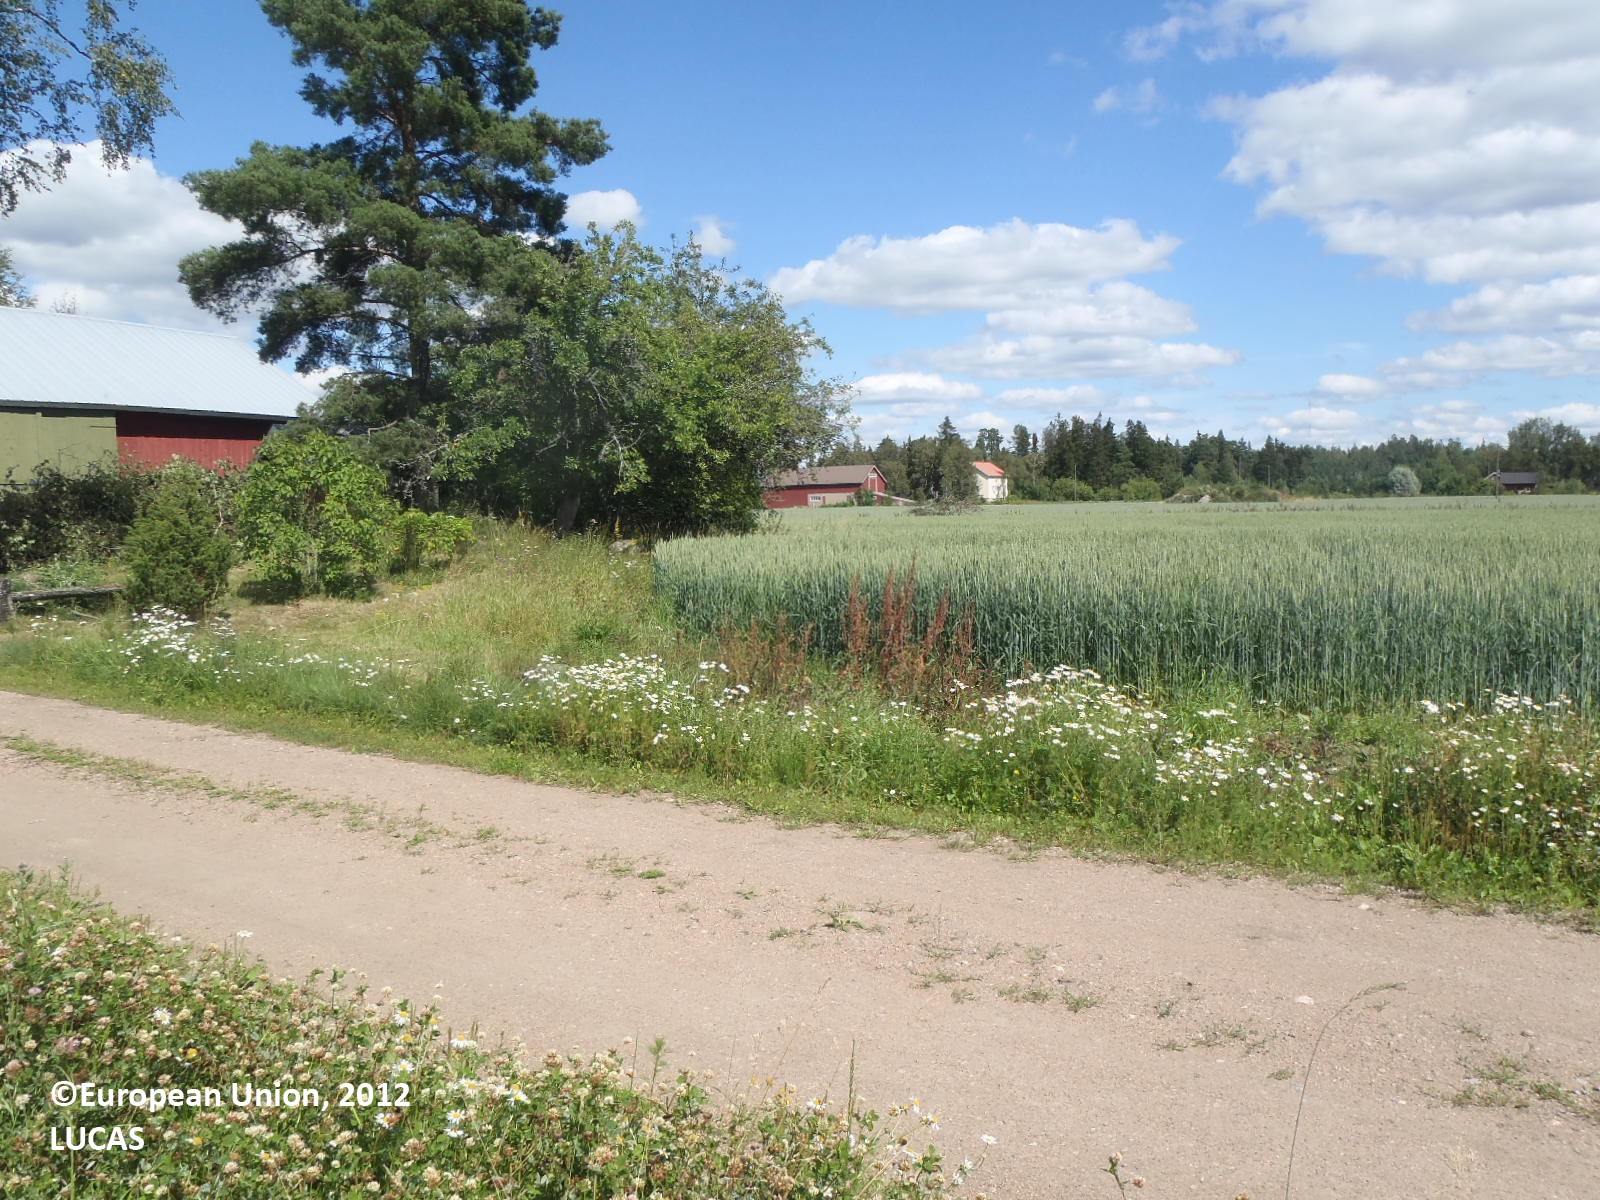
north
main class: Cropland
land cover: Common wheat
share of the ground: > 75 %
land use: Agriculture (excluding fallow land and kitchen gardens)
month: July
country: FI
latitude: 60.6392
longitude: 21.9276
